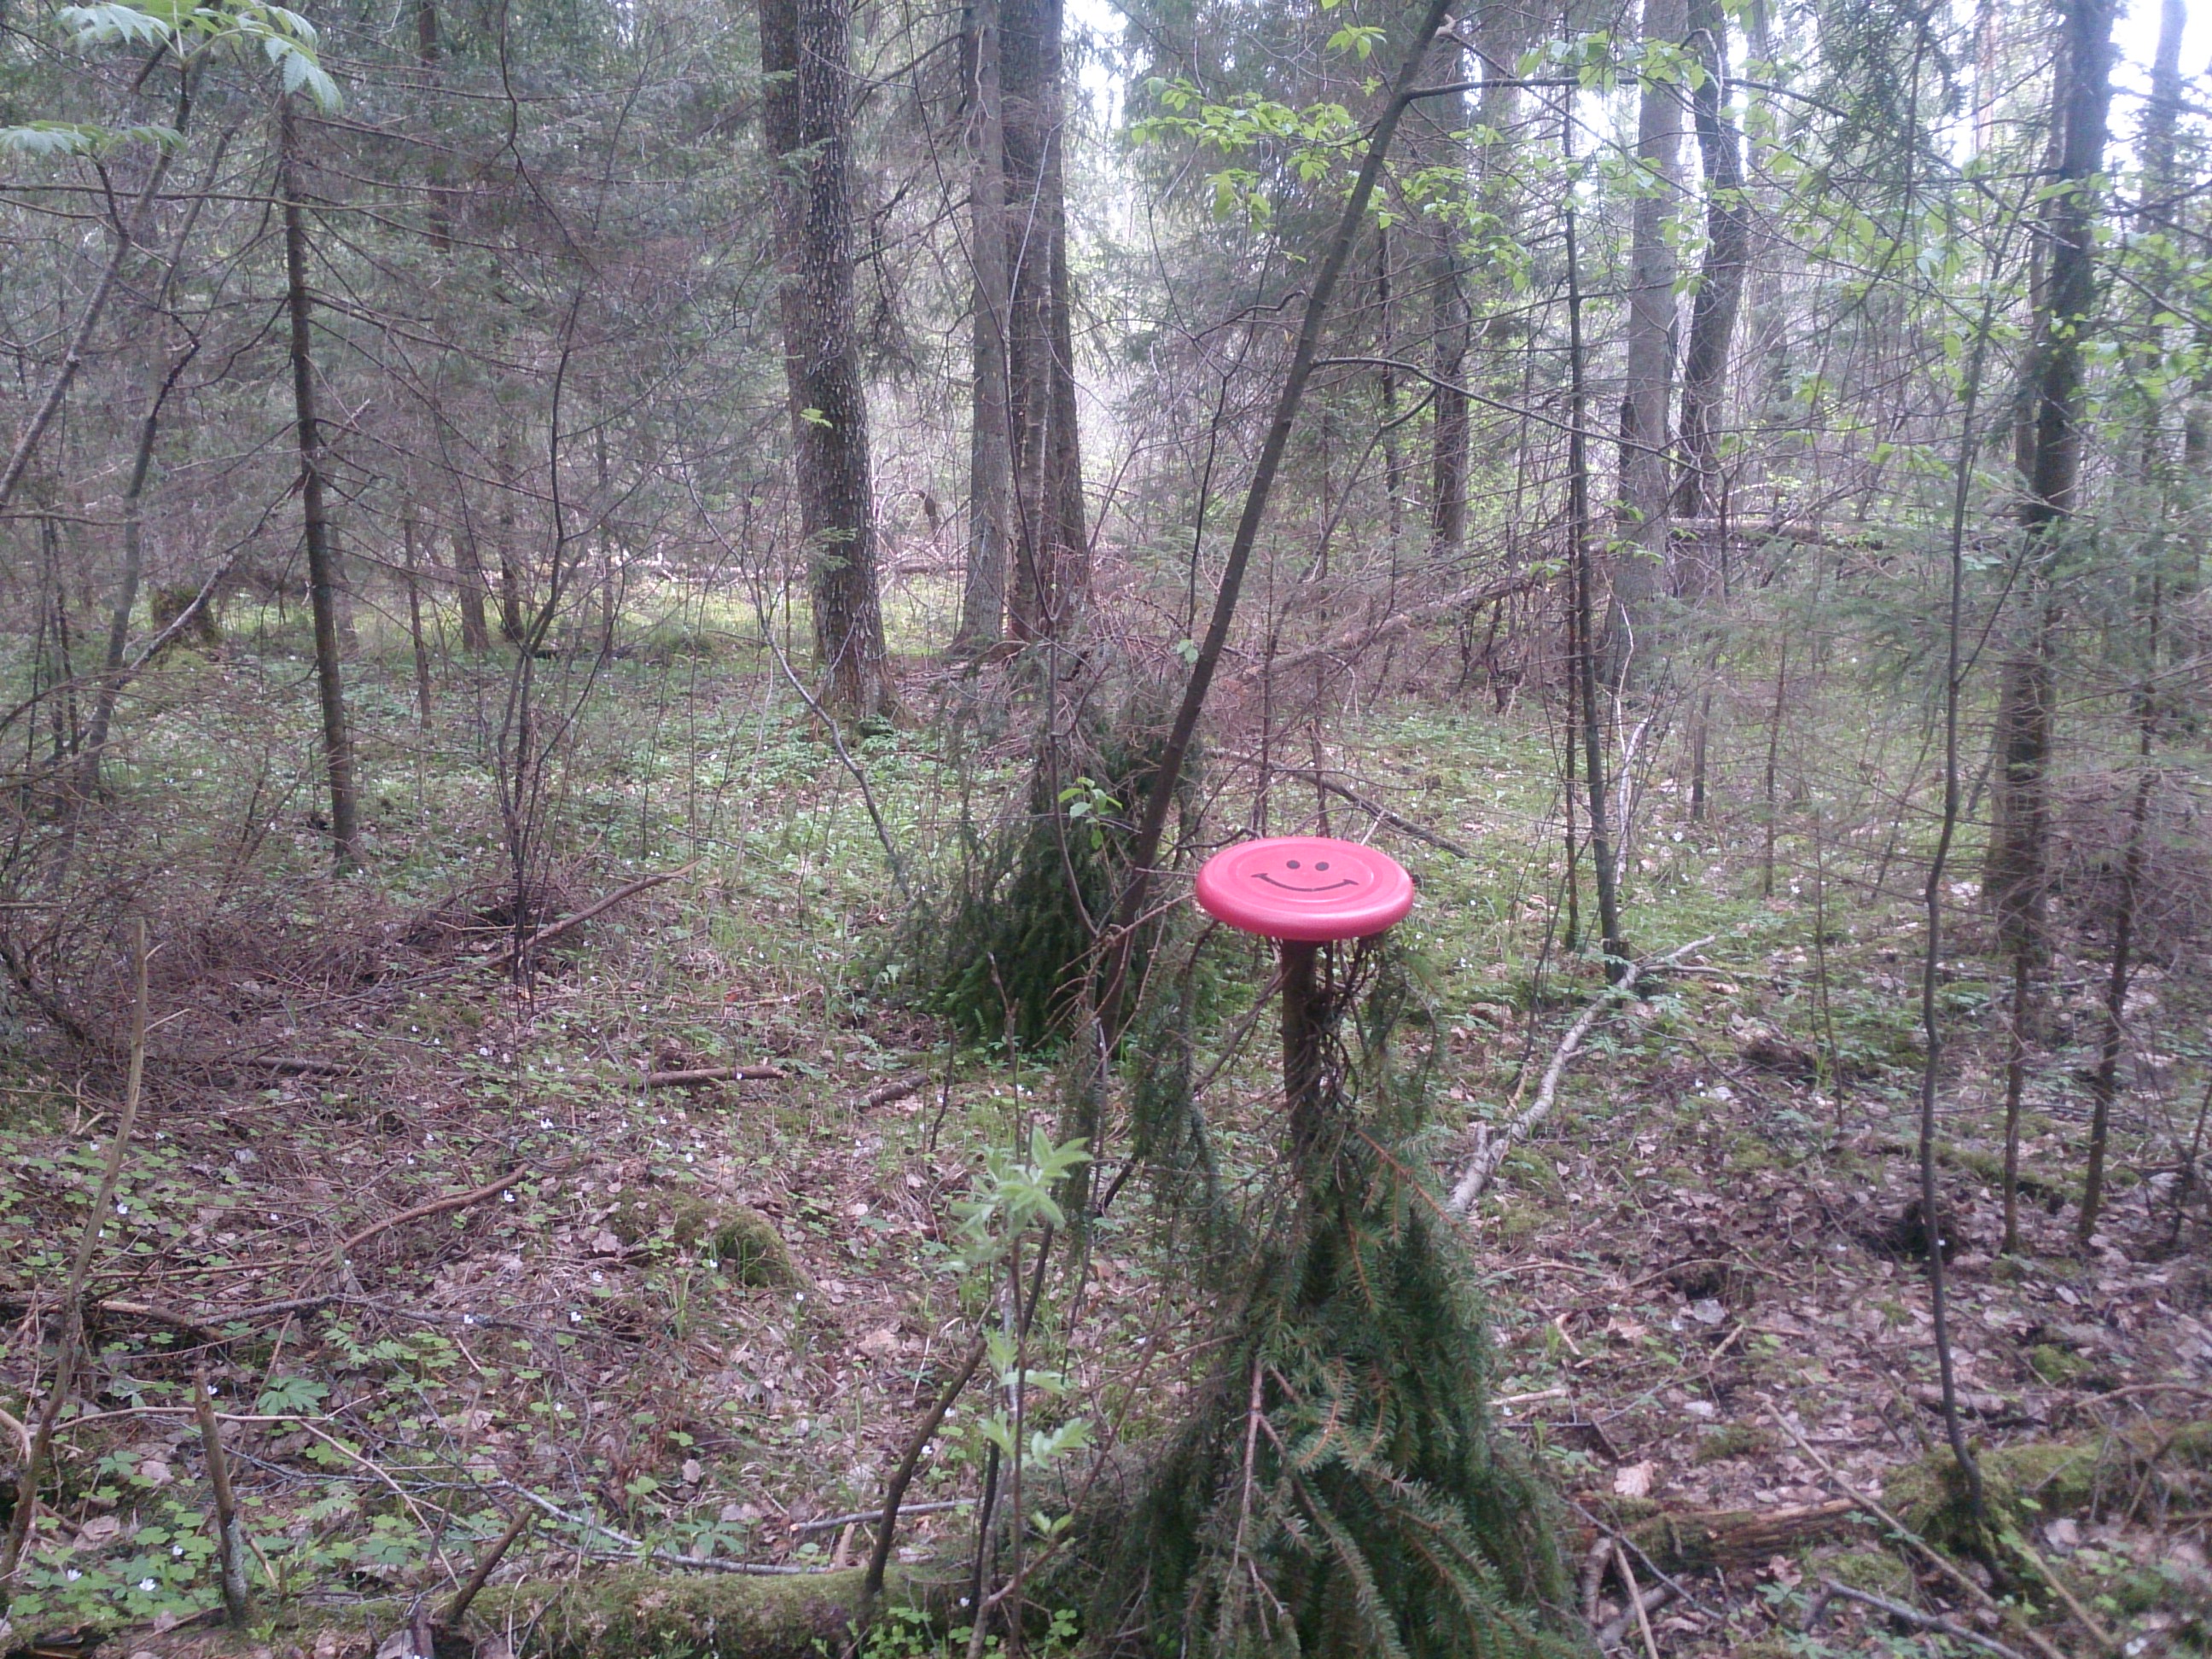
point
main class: Woodland
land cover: Other mixed woodland
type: hemiboreal forest and nemoral coniferous forest and mixed broadleaved-coniferous forest
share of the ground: > 75 %
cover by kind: coniferous forest trees 70 %, broadleaved forest trees 30 %
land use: Forestry
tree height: > 5 m
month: May
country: LV
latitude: 56.6935
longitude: 24.1797
